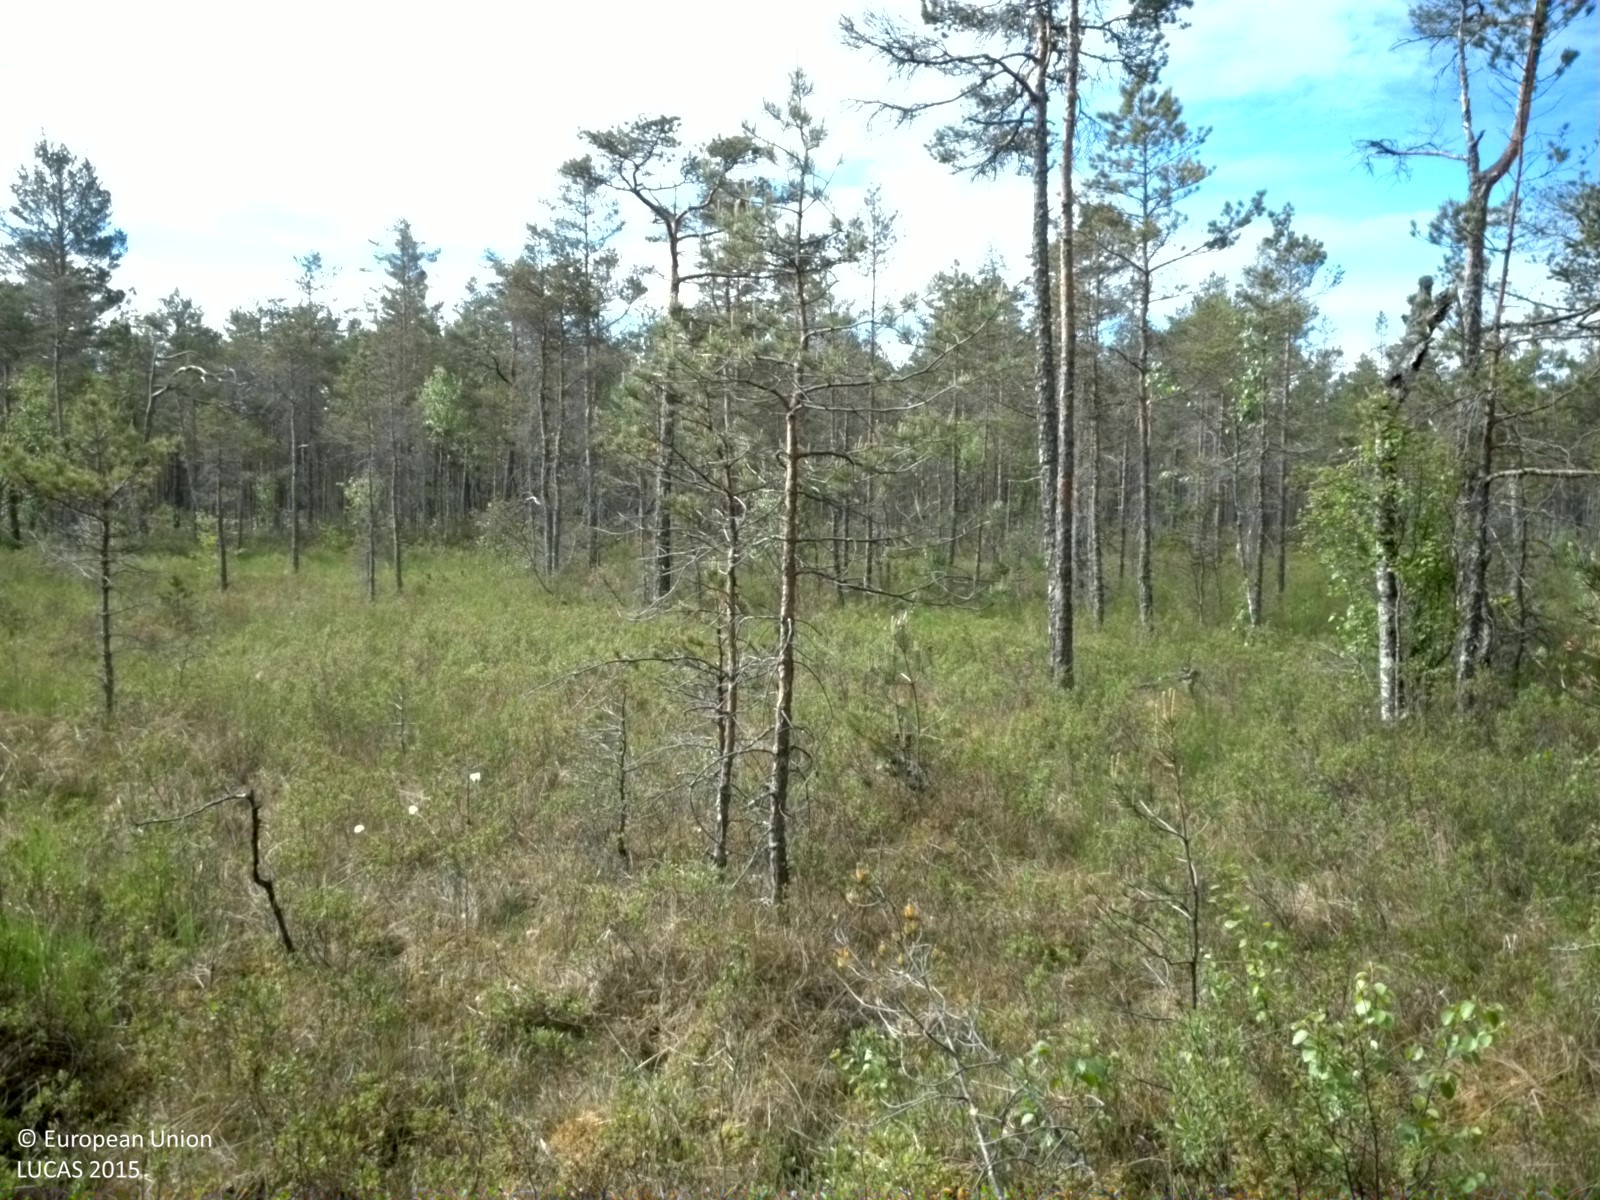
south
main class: Woodland
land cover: Pine dominated coniferous woodland
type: mire and swamp forests
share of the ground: 25 - 50 %
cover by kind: coniferous forest trees 40 %, shrubs 25 %, herbaceous plants 15 %, lichens and mosses 15 %, broadleaved forest trees 5 %
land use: Semi-natural and natural areas not in use
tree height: > 5 m
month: June
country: SE
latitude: 60.2481
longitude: 17.2355
